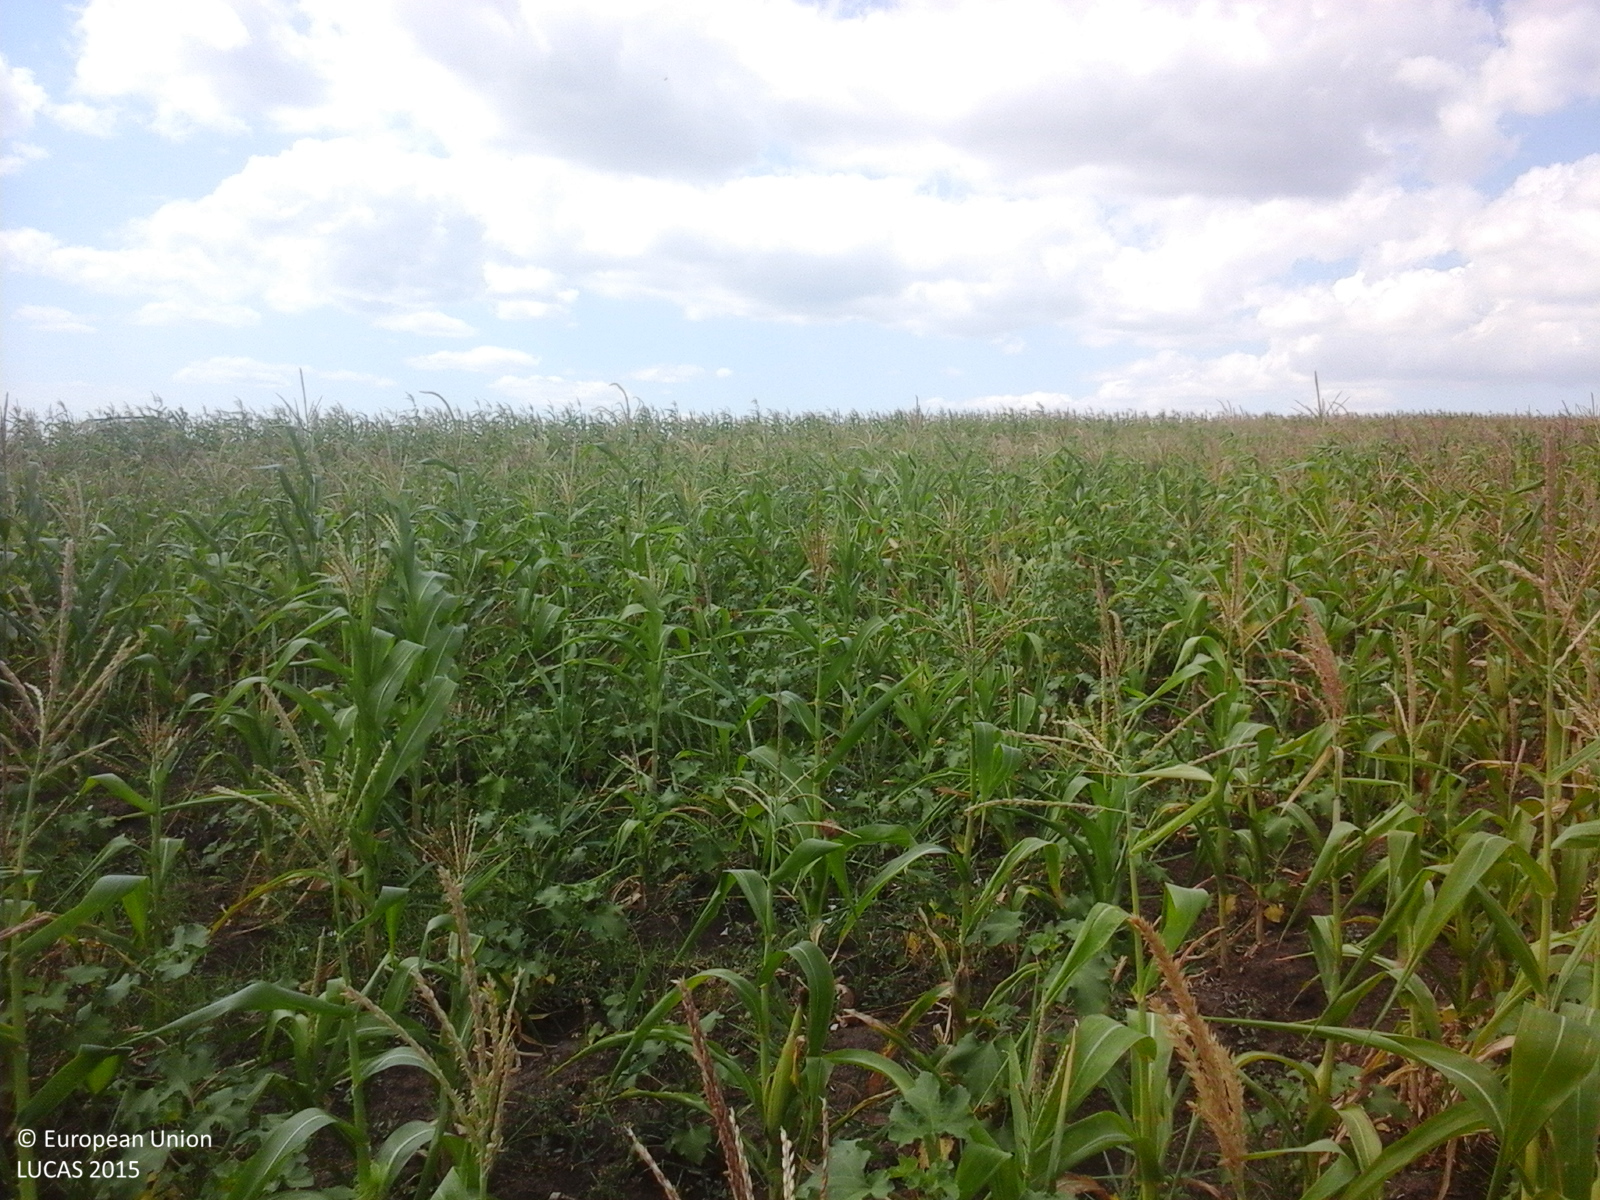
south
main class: Cropland
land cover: Maize
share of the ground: > 75 %
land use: Agriculture (excluding fallow land and kitchen gardens)
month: July
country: RO
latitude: 46.3660
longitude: 27.9443
